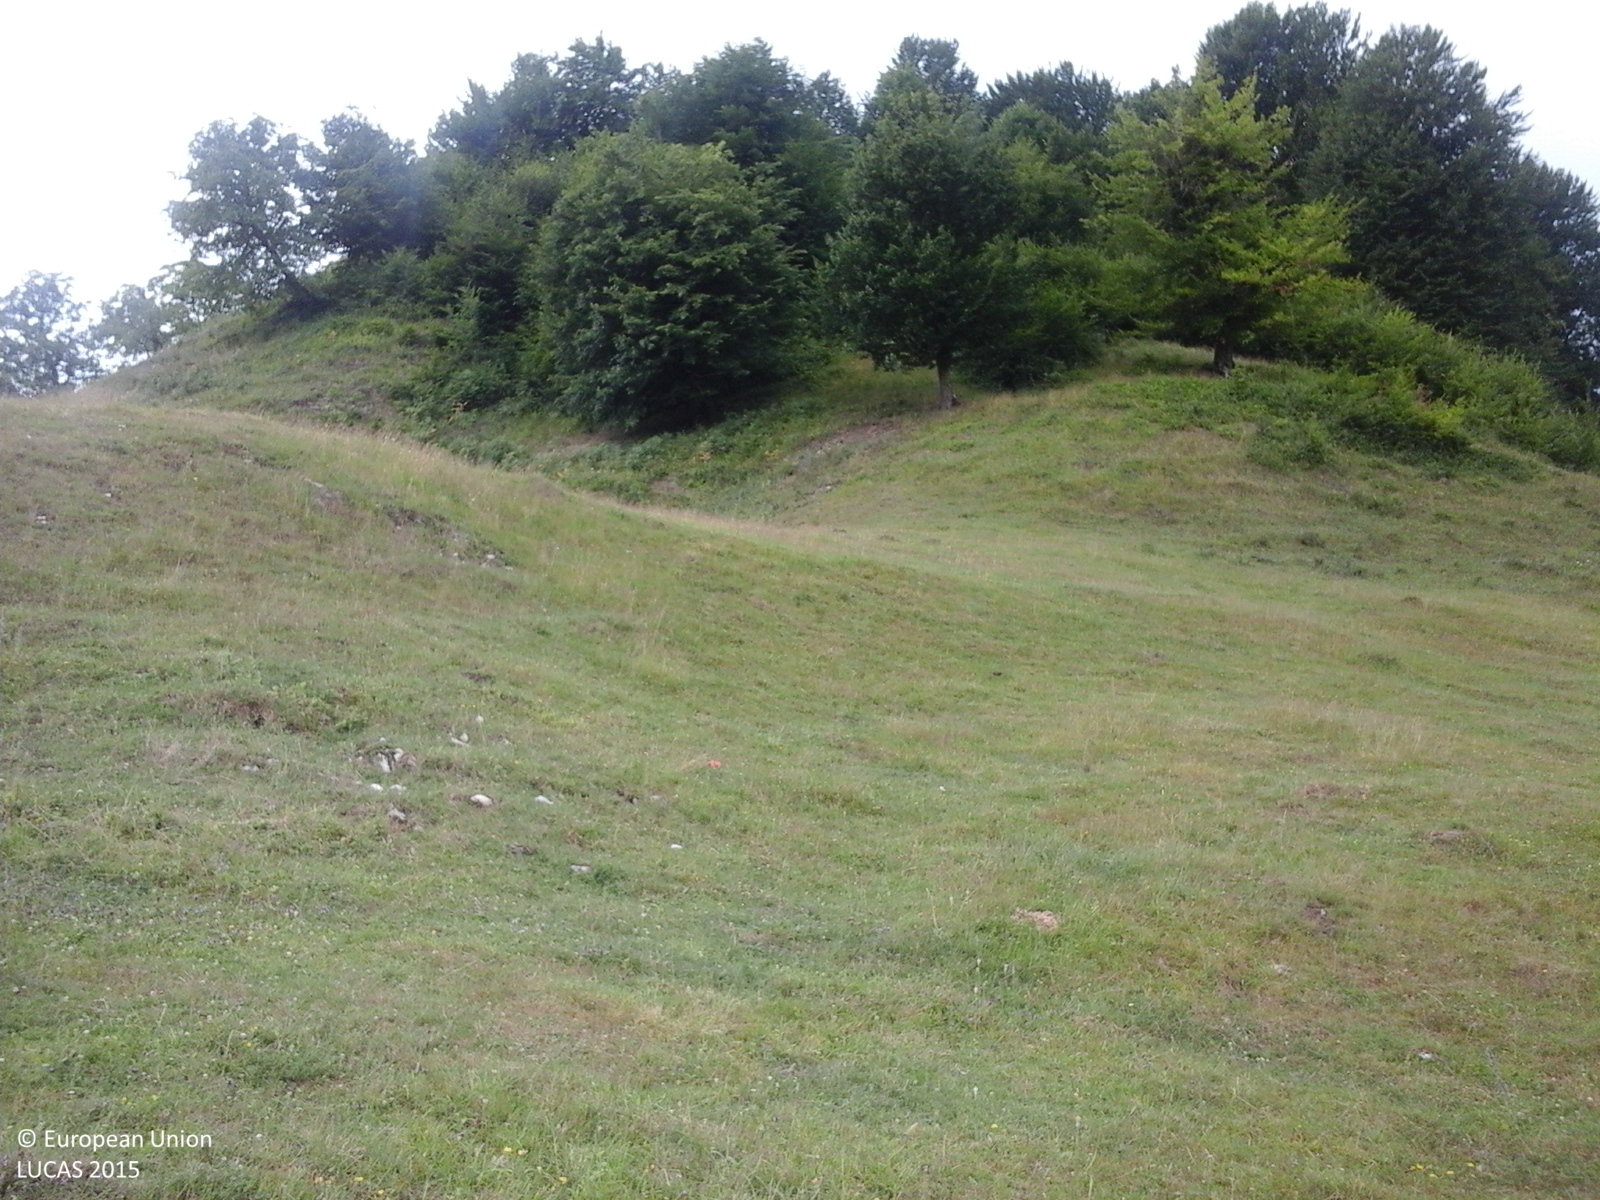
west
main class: Grassland
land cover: Grassland without tree/shrub cover
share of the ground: > 75 %
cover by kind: herbaceous plants 100 %
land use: Agriculture (excluding fallow land and kitchen gardens)
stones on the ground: < 10 %
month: July
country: RO
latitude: 45.2806
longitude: 24.6520
